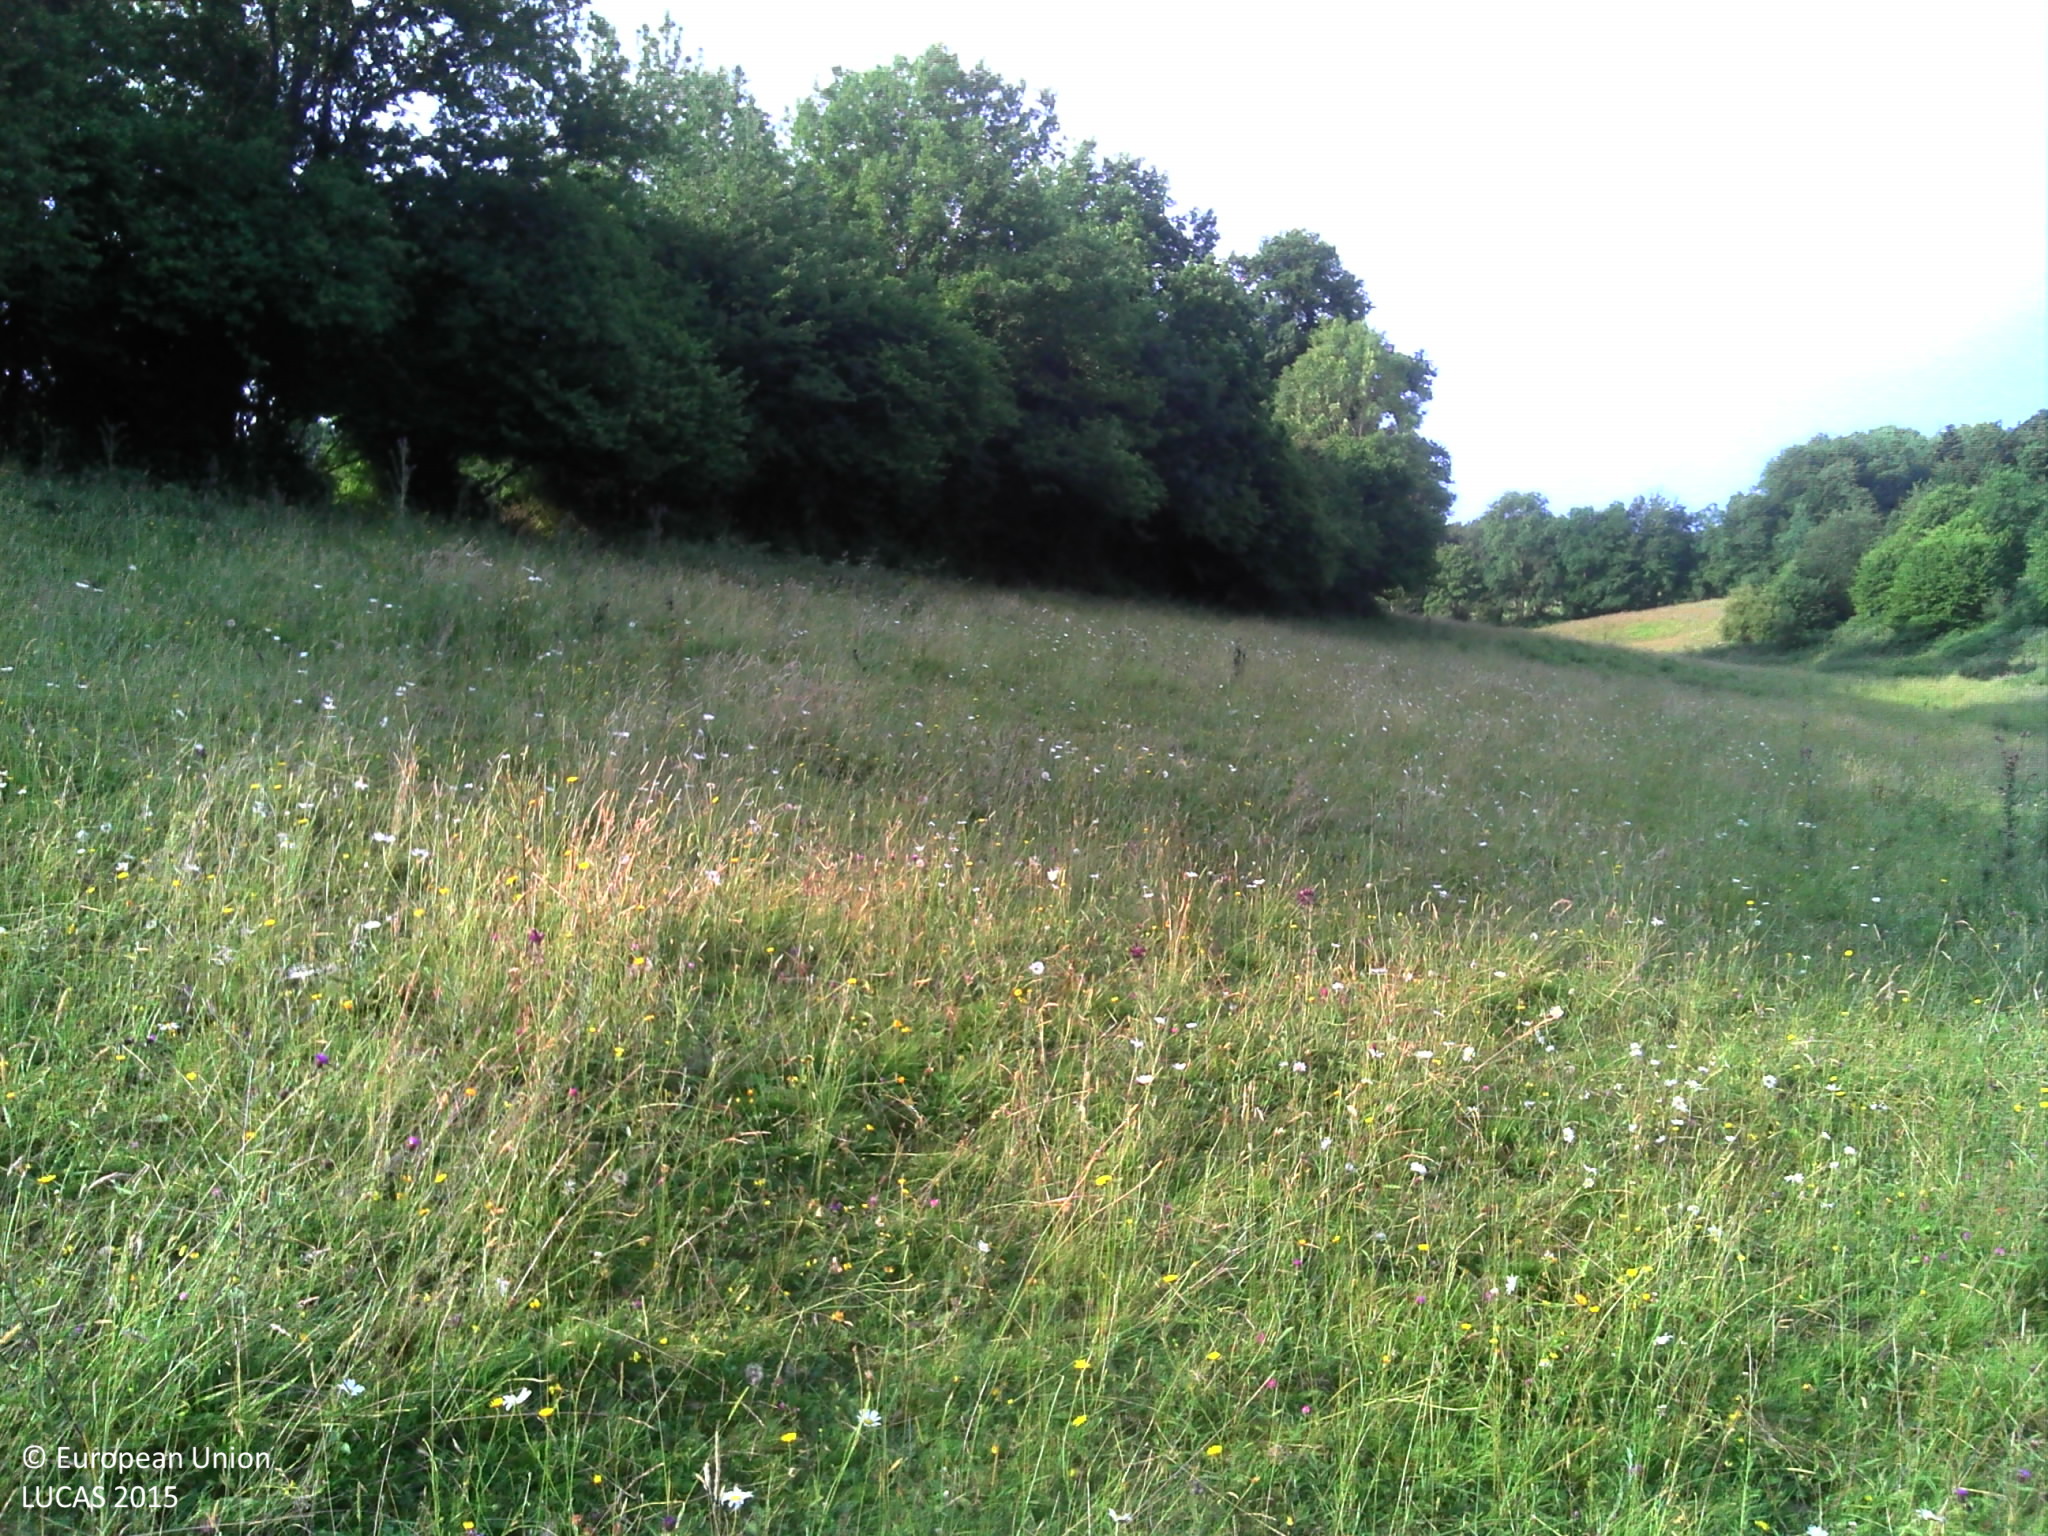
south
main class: Grassland
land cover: Grassland without tree/shrub cover
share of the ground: > 75 %
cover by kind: herbaceous plants 100 %
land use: Agriculture (excluding fallow land and kitchen gardens)
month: July
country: FR
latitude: 48.9903
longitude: 0.0895
